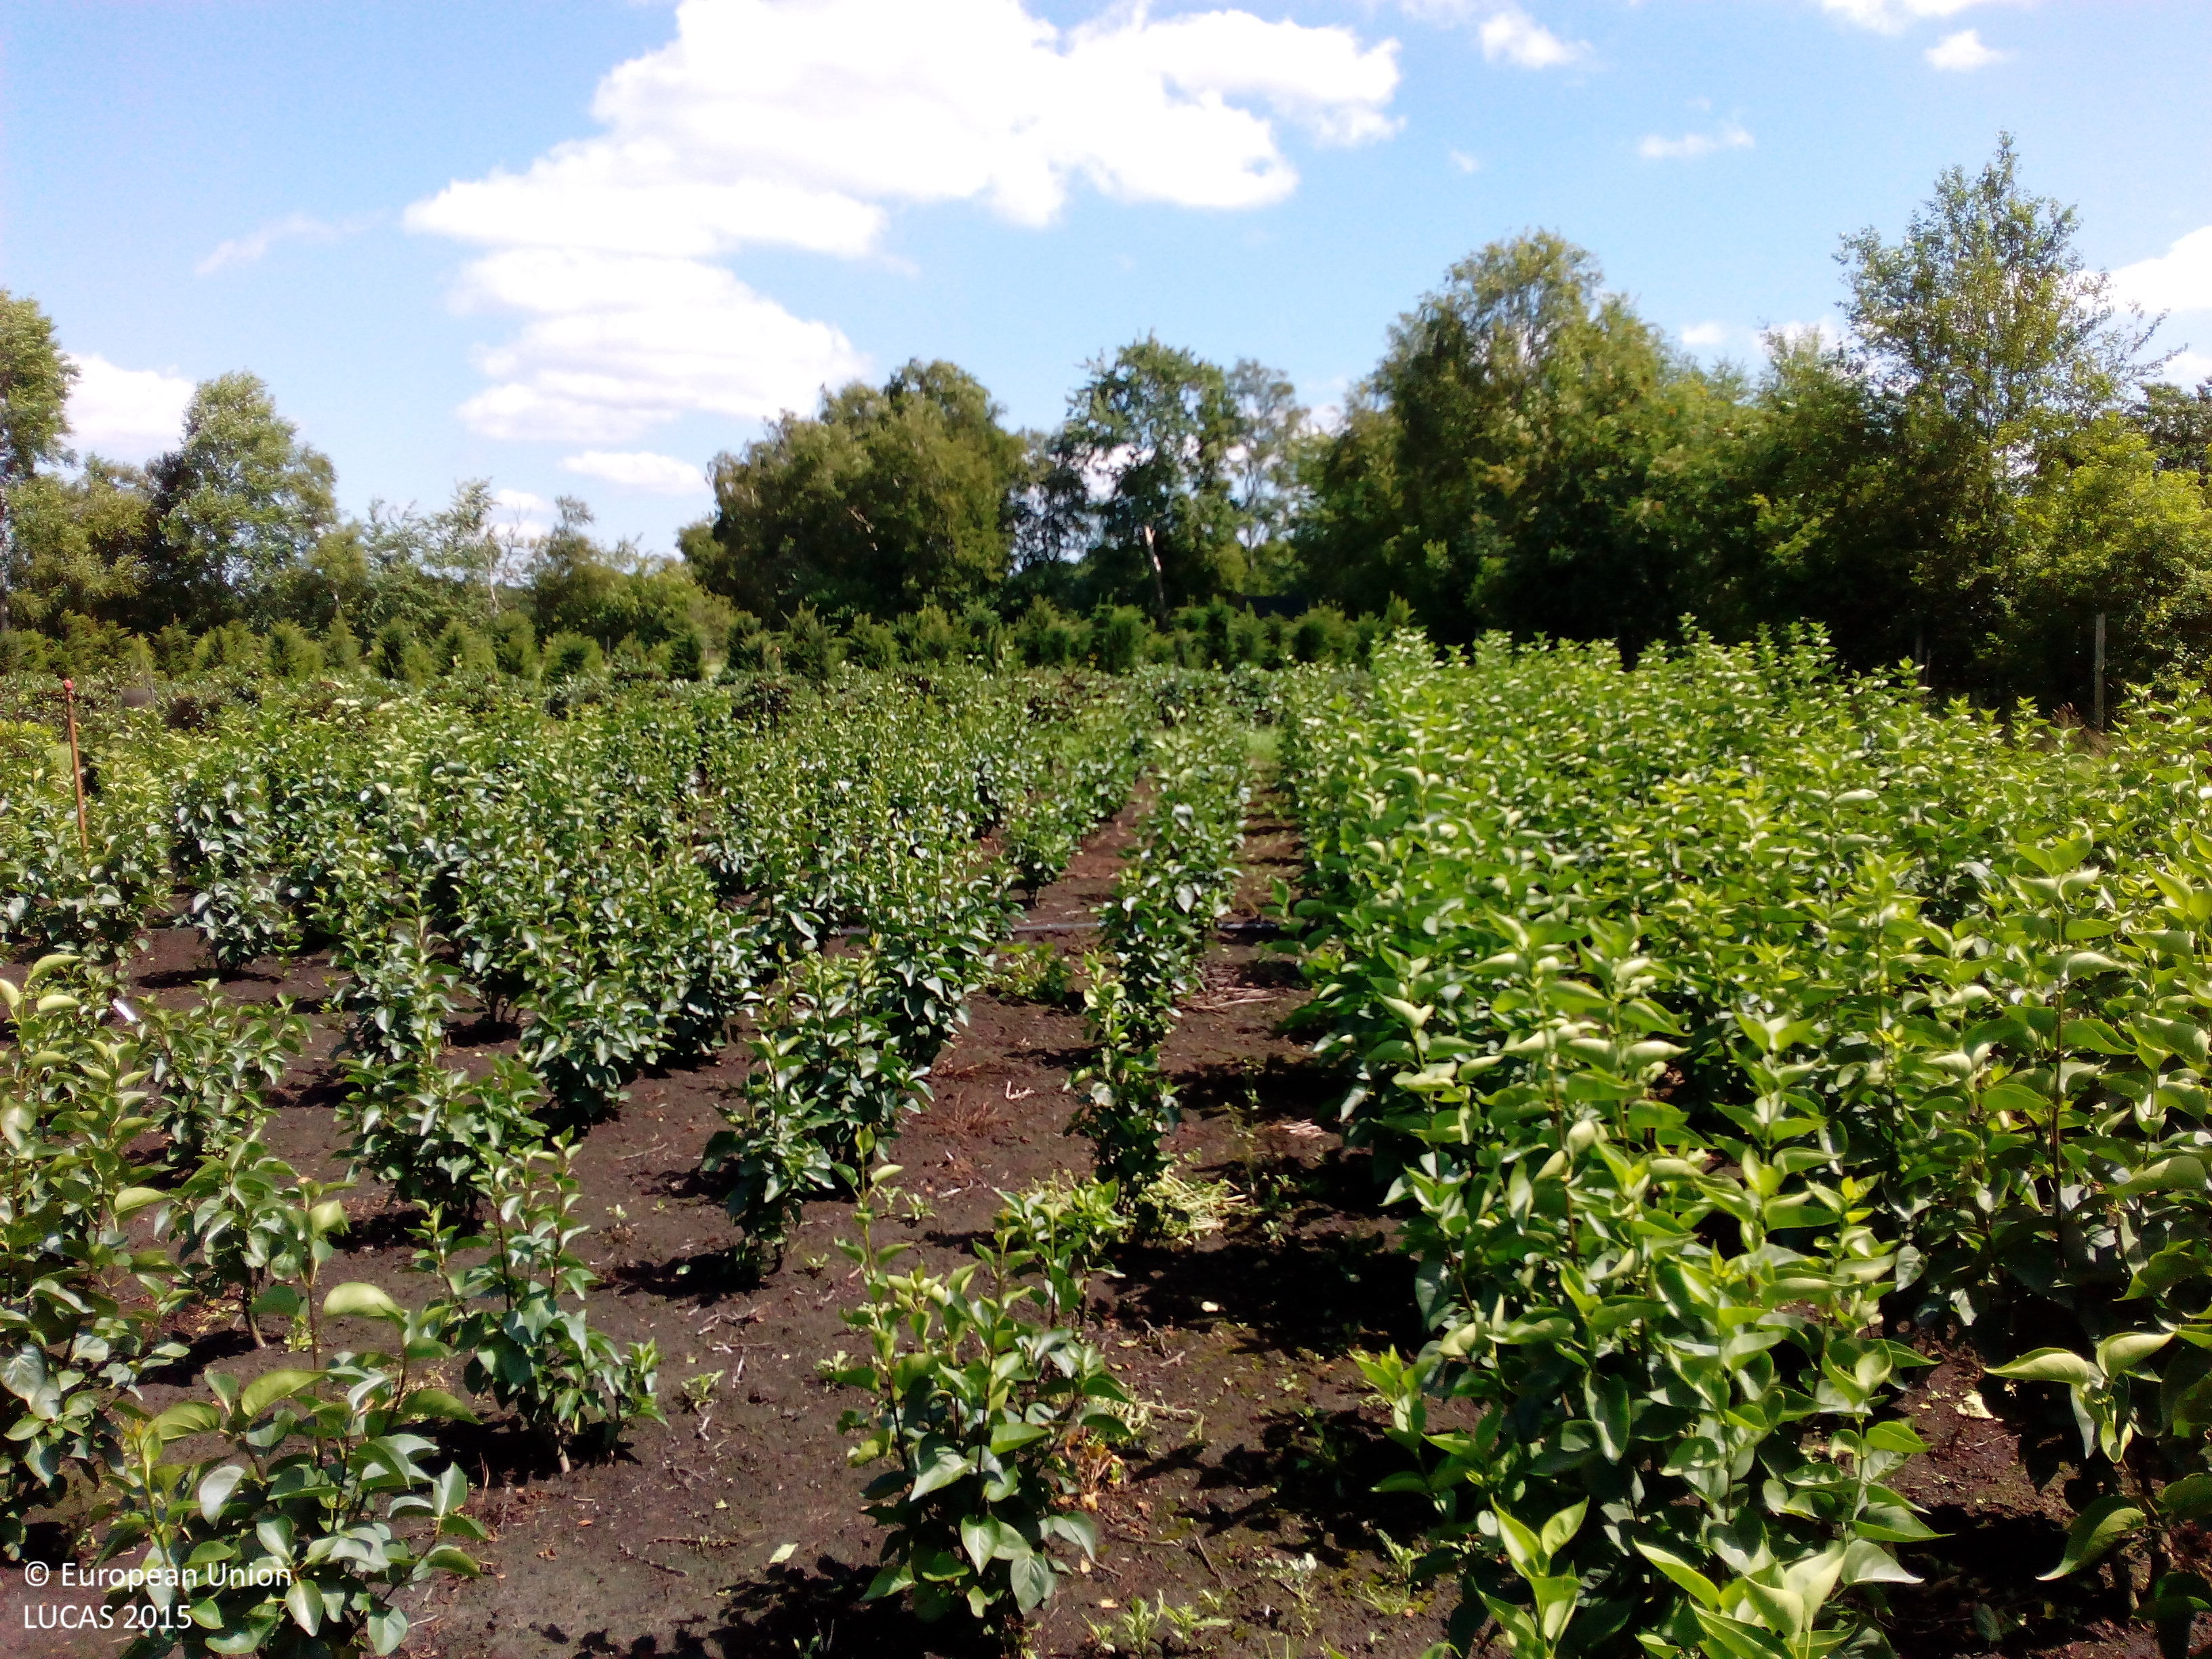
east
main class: Cropland
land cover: Nurseries
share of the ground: > 75 %
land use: Agriculture (excluding fallow land and kitchen gardens)
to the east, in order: Nurseries; Grassland without tree/shrub cover; Fences; Broadleaved woodland; Ditches and canals; Maize; Shruby margins; Ditches and canals
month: July
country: DE
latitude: 53.1684
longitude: 7.9213
